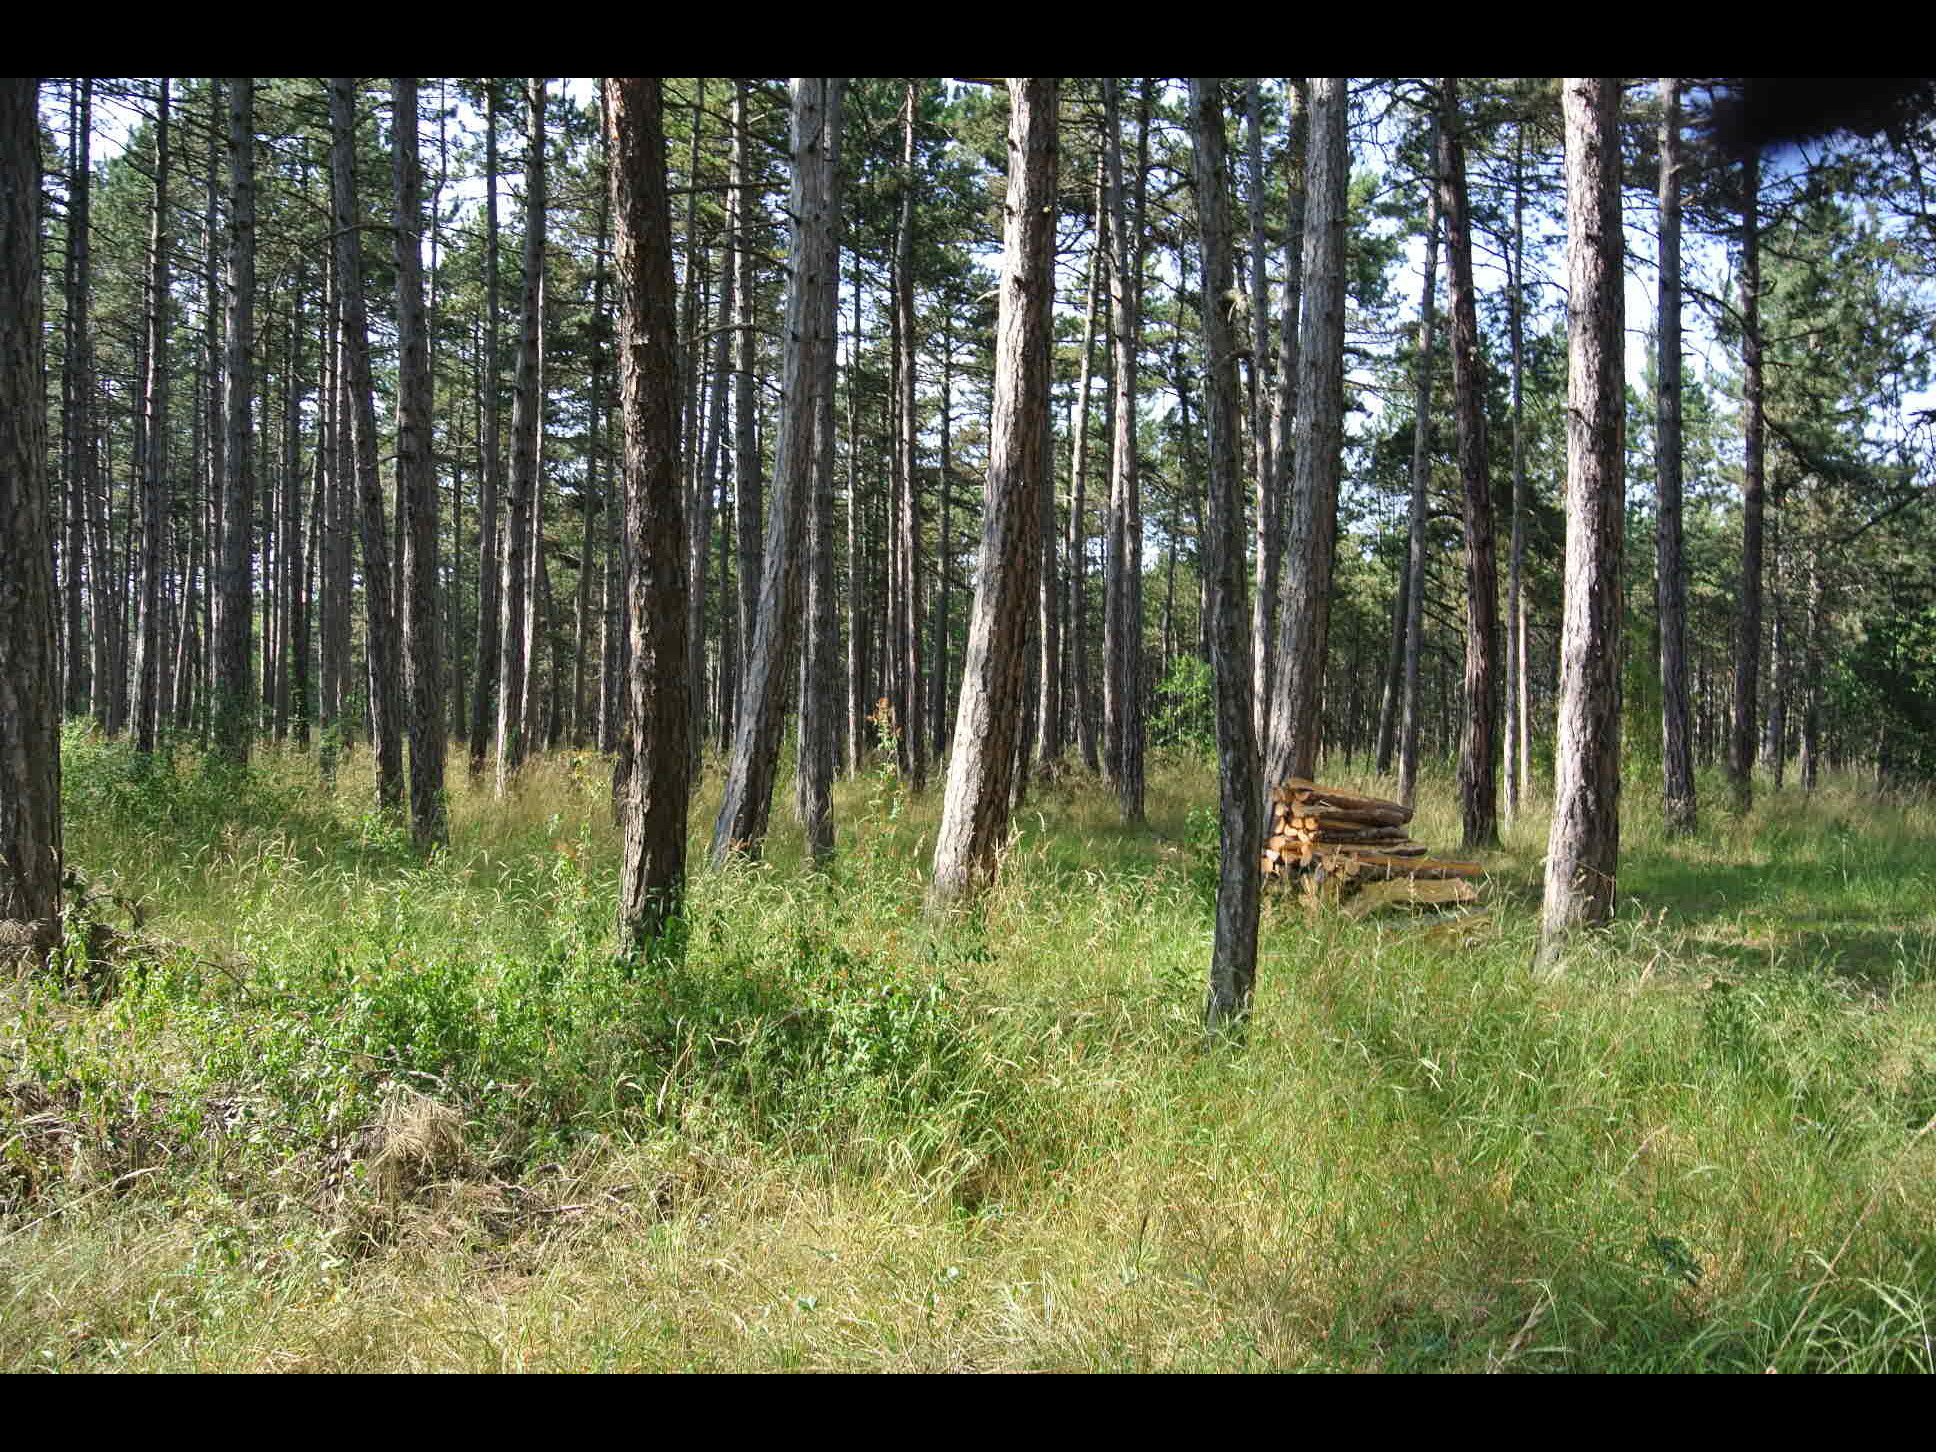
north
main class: Woodland
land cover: Pine dominated coniferous woodland
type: alpine coniferous forest
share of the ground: 25 - 50 %
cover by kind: coniferous forest trees 90 %, herbaceous plants 10 %
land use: Forestry
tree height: > 5 m
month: July
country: AT
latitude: 47.7629
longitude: 16.1538
